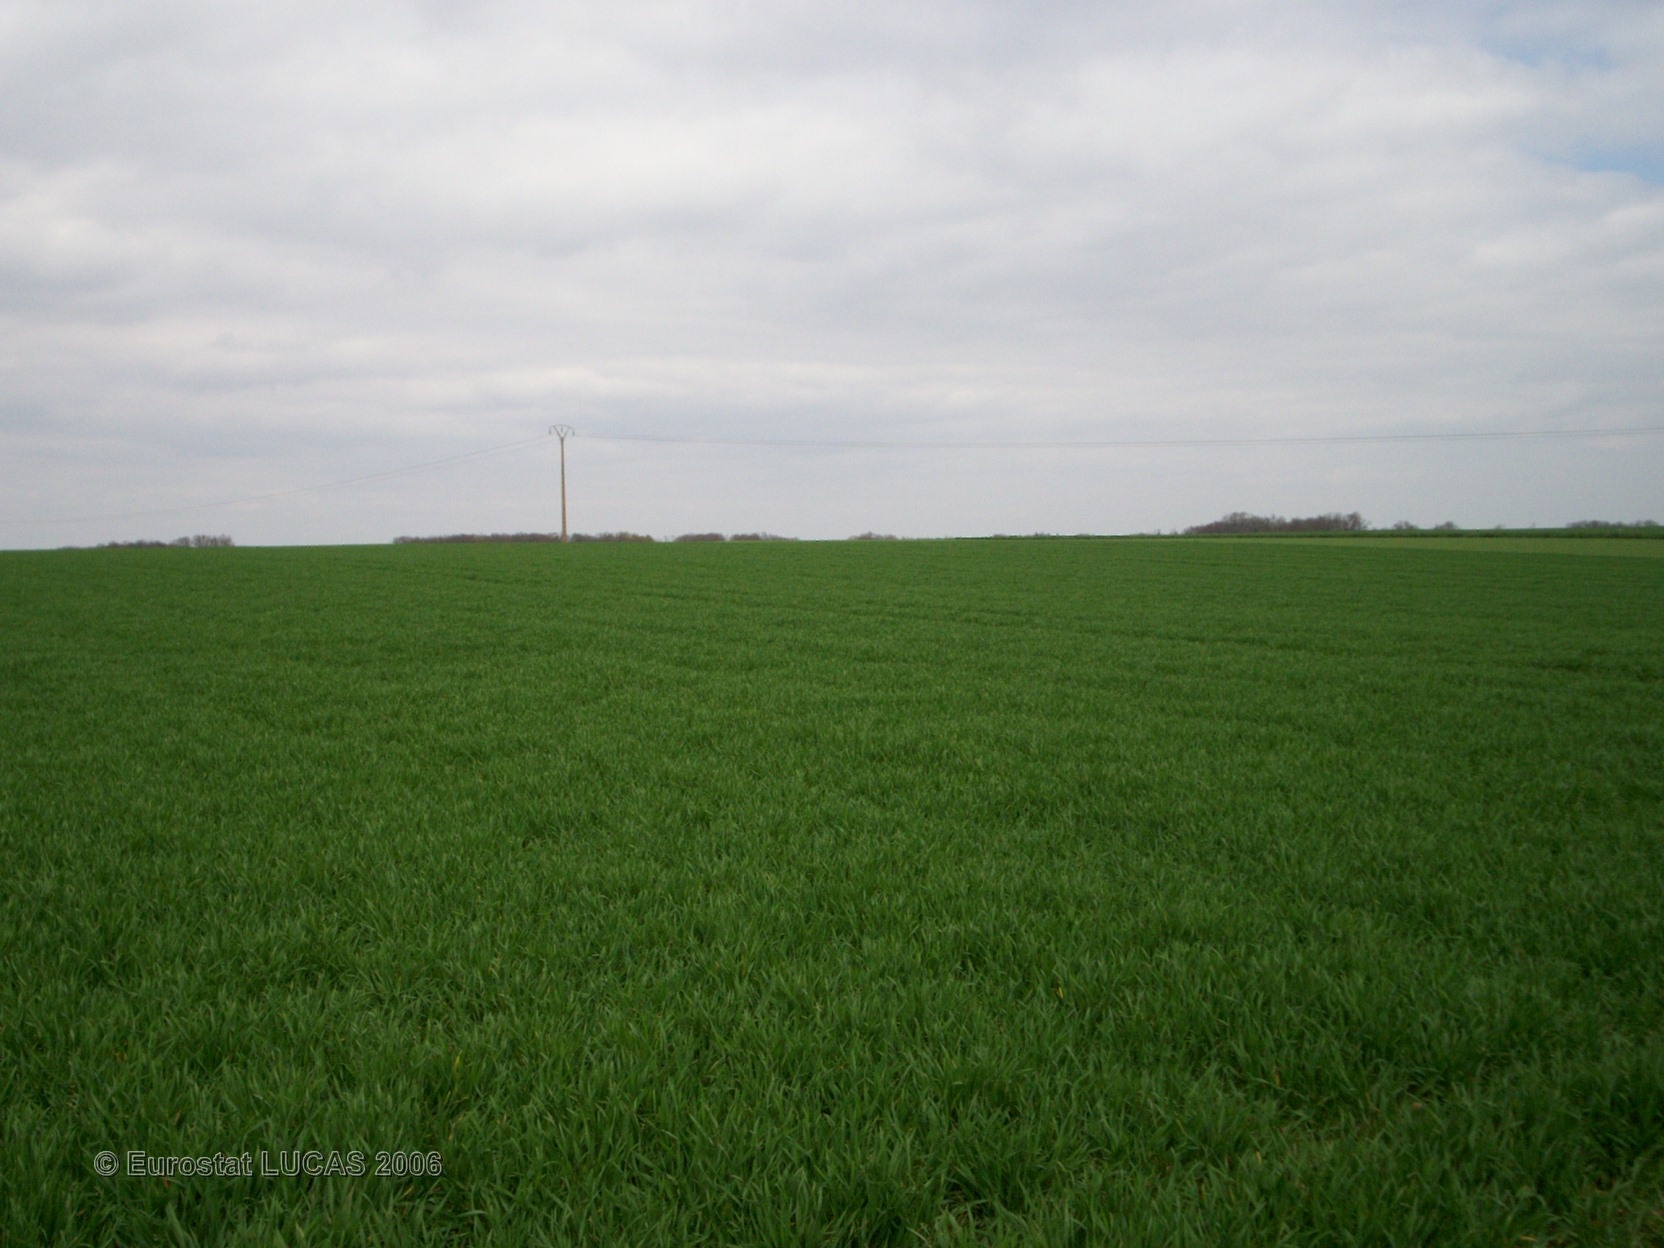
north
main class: Cropland
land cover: Common wheat
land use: Agriculture (excluding fallow land and kitchen gardens)
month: April
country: FR
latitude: 48.2615
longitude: 2.8387
